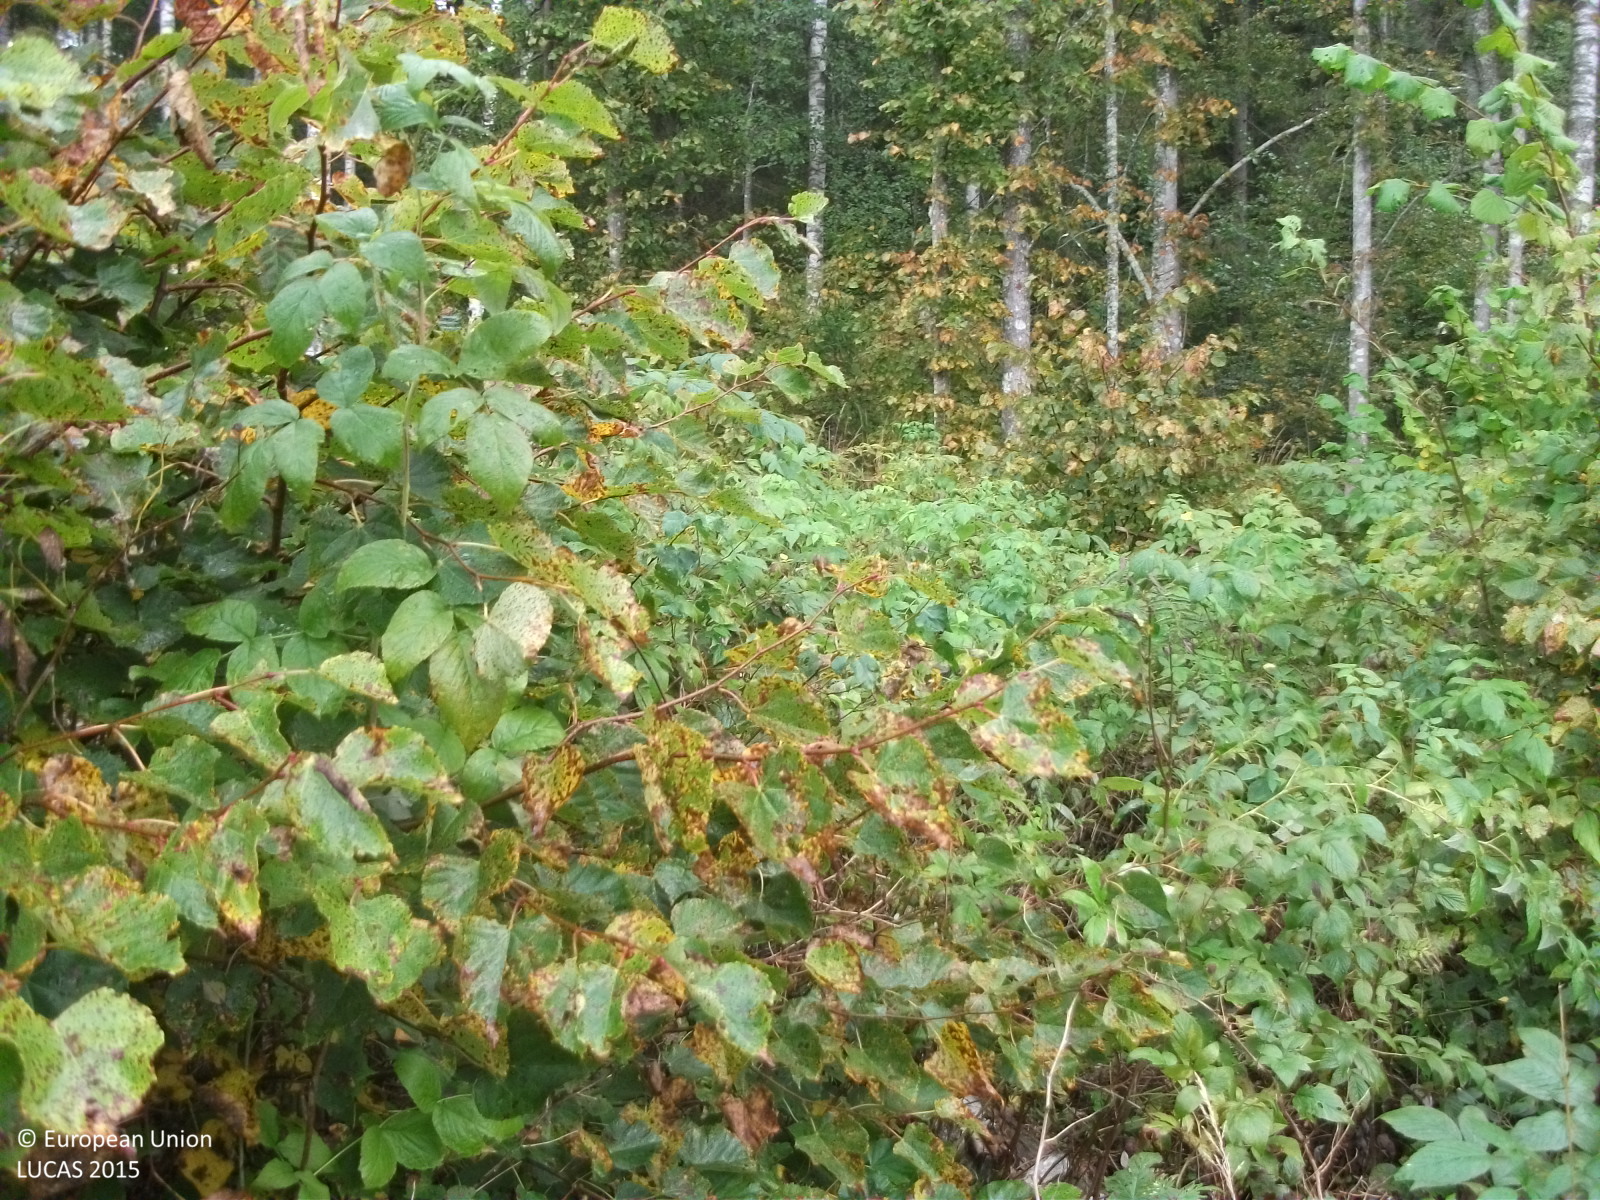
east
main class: Shrubland
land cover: Shrubland with sparse tree cover
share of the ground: > 75 %
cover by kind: shrubs 70 %, herbaceous plants 25 %, broadleaved forest trees 5 %
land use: Forestry
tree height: < 5 m
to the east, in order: Shrubland with sparse tree cover; Broadleaved woodland; Ditches and canals; Spruce dominated coniferous woodland; Spruce dominated mixed woodland; Broadleaved woodland
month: September
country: LV
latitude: 57.7403
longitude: 24.4850
